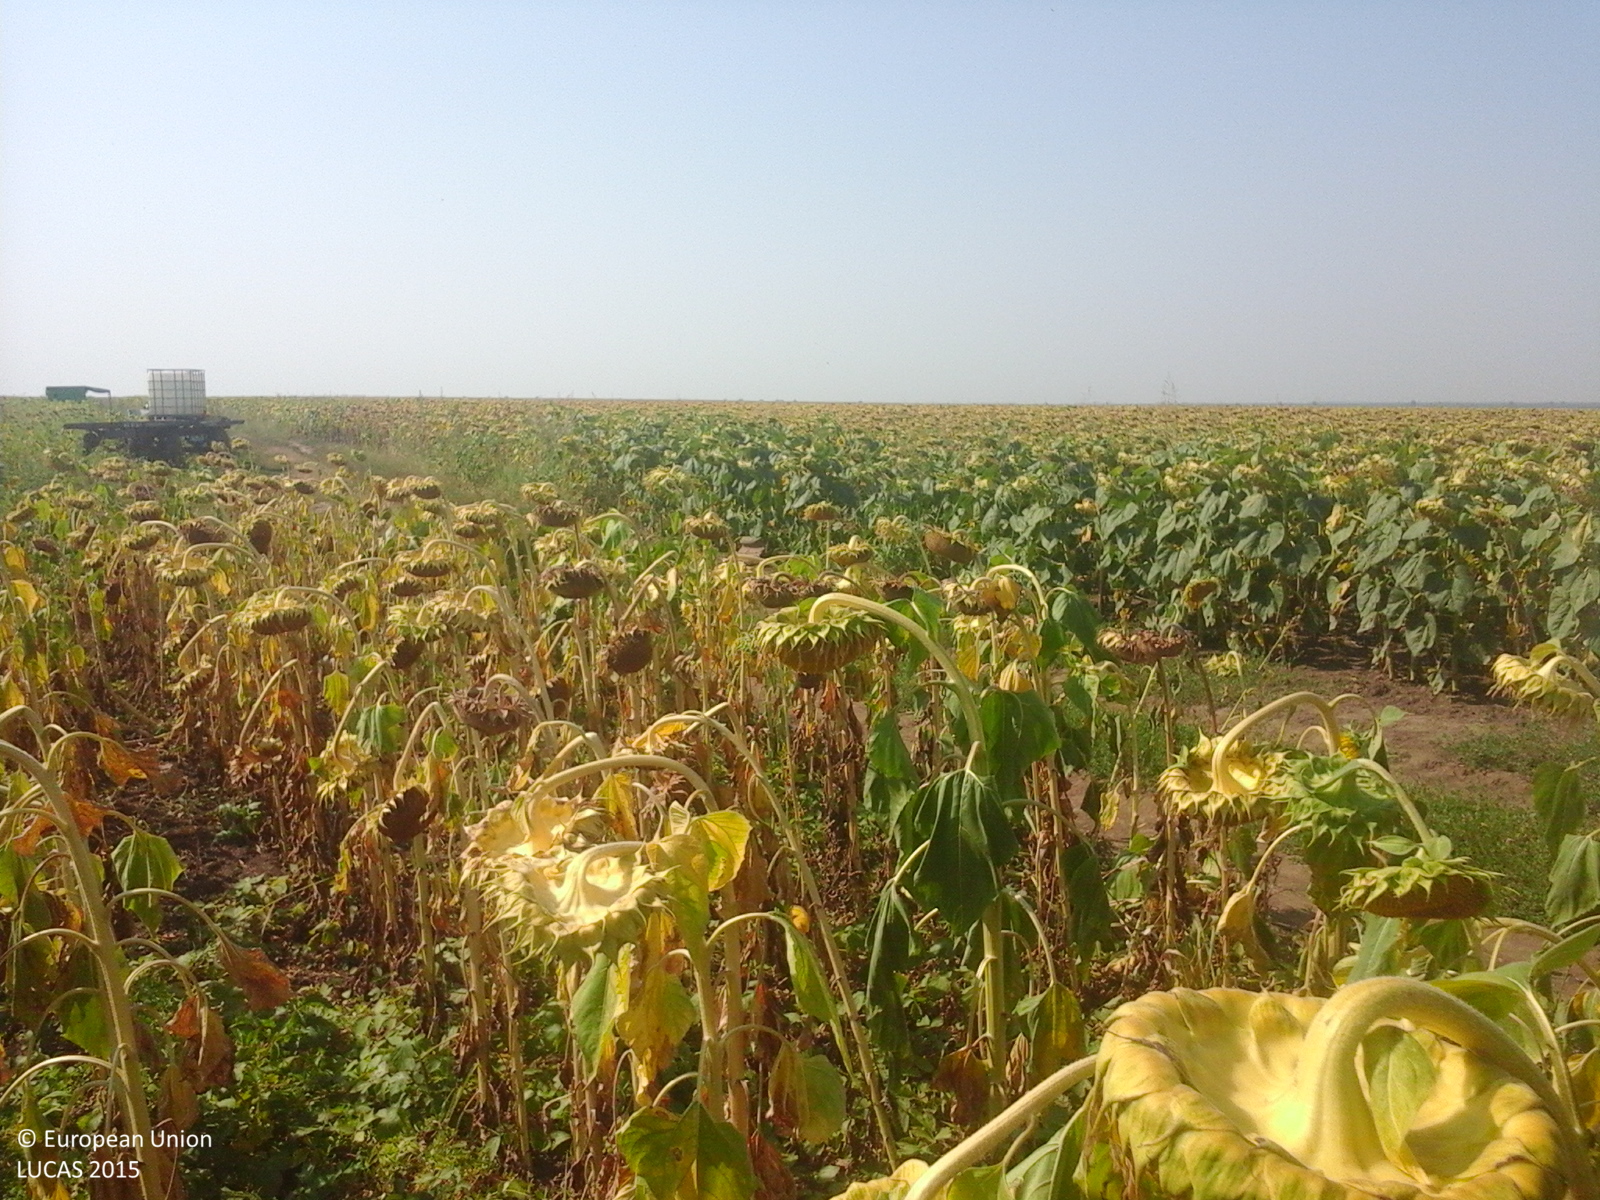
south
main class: Cropland
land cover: Sunflower
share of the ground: > 75 %
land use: Agriculture (excluding fallow land and kitchen gardens)
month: August
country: RO
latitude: 45.7251
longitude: 27.5946
